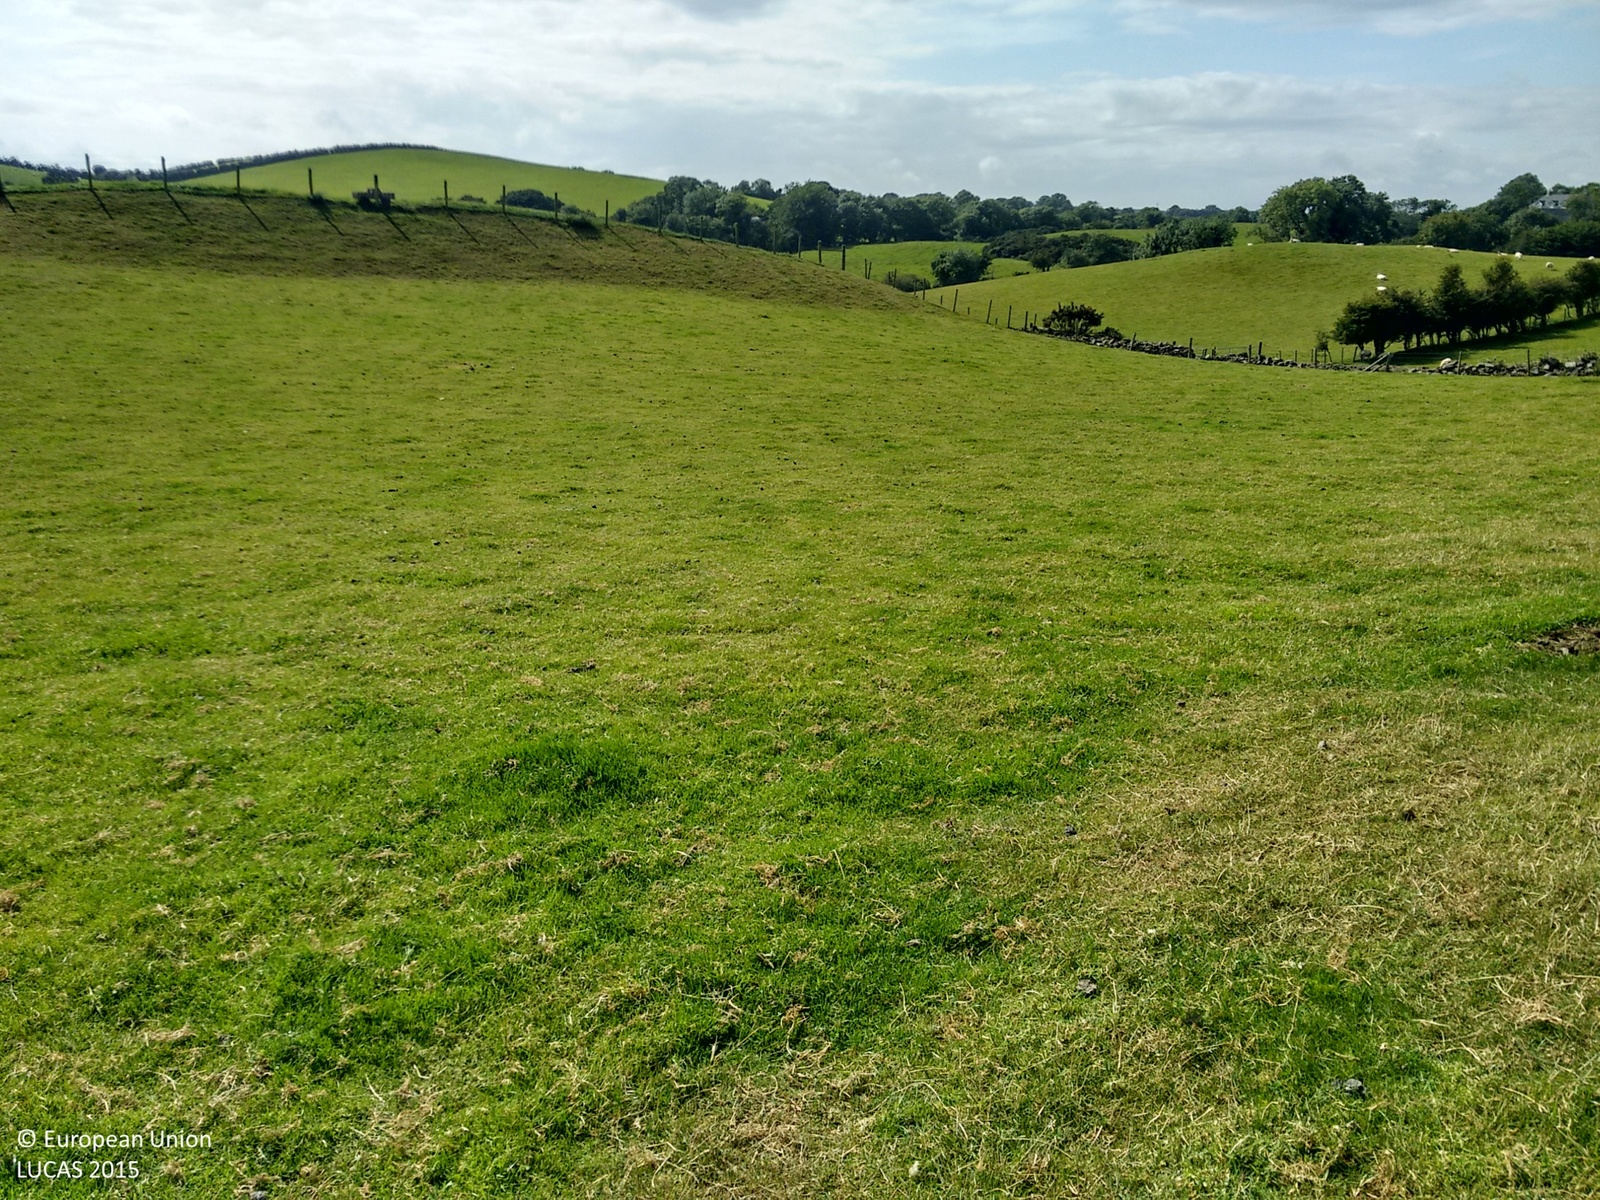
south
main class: Grassland
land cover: Grassland without tree/shrub cover
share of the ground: > 75 %
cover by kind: herbaceous plants 100 %
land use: Agriculture (excluding fallow land and kitchen gardens)
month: August
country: GB
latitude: 54.4639
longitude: -5.6677
